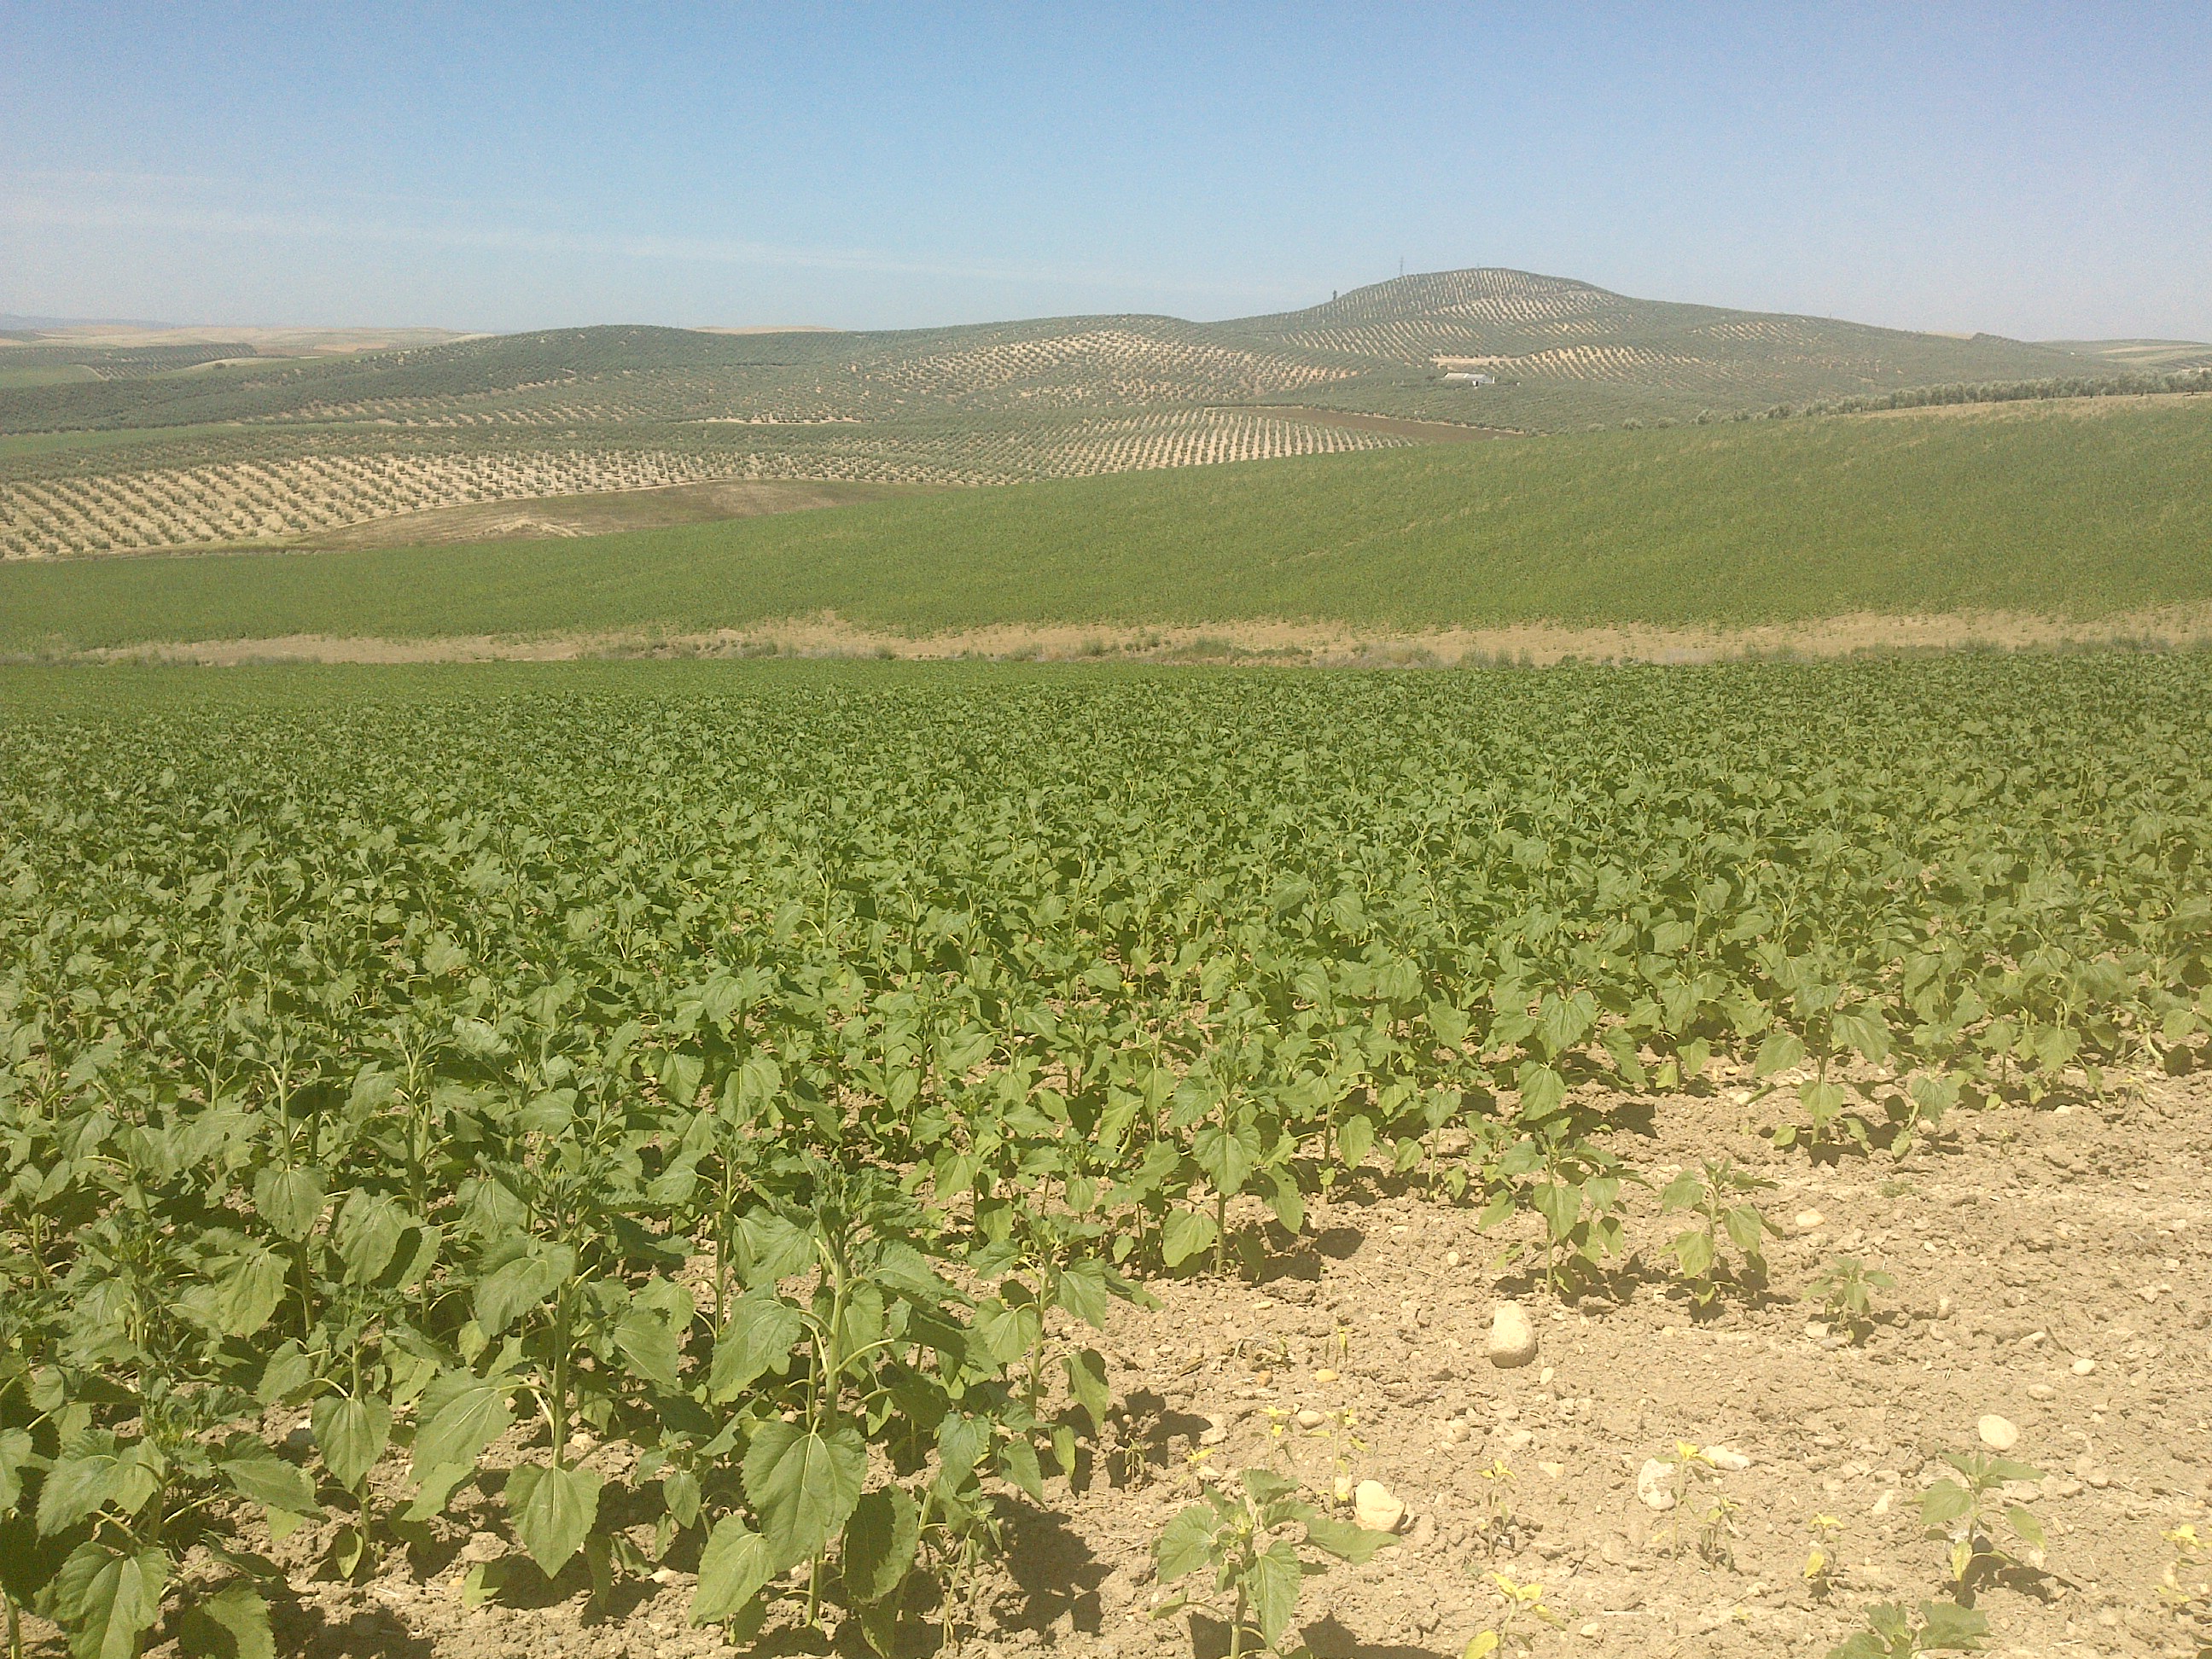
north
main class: Cropland
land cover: Sunflower
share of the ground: > 75 %
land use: Agriculture (excluding fallow land and kitchen gardens)
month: May
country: ES
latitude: 37.7482
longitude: -4.6394
